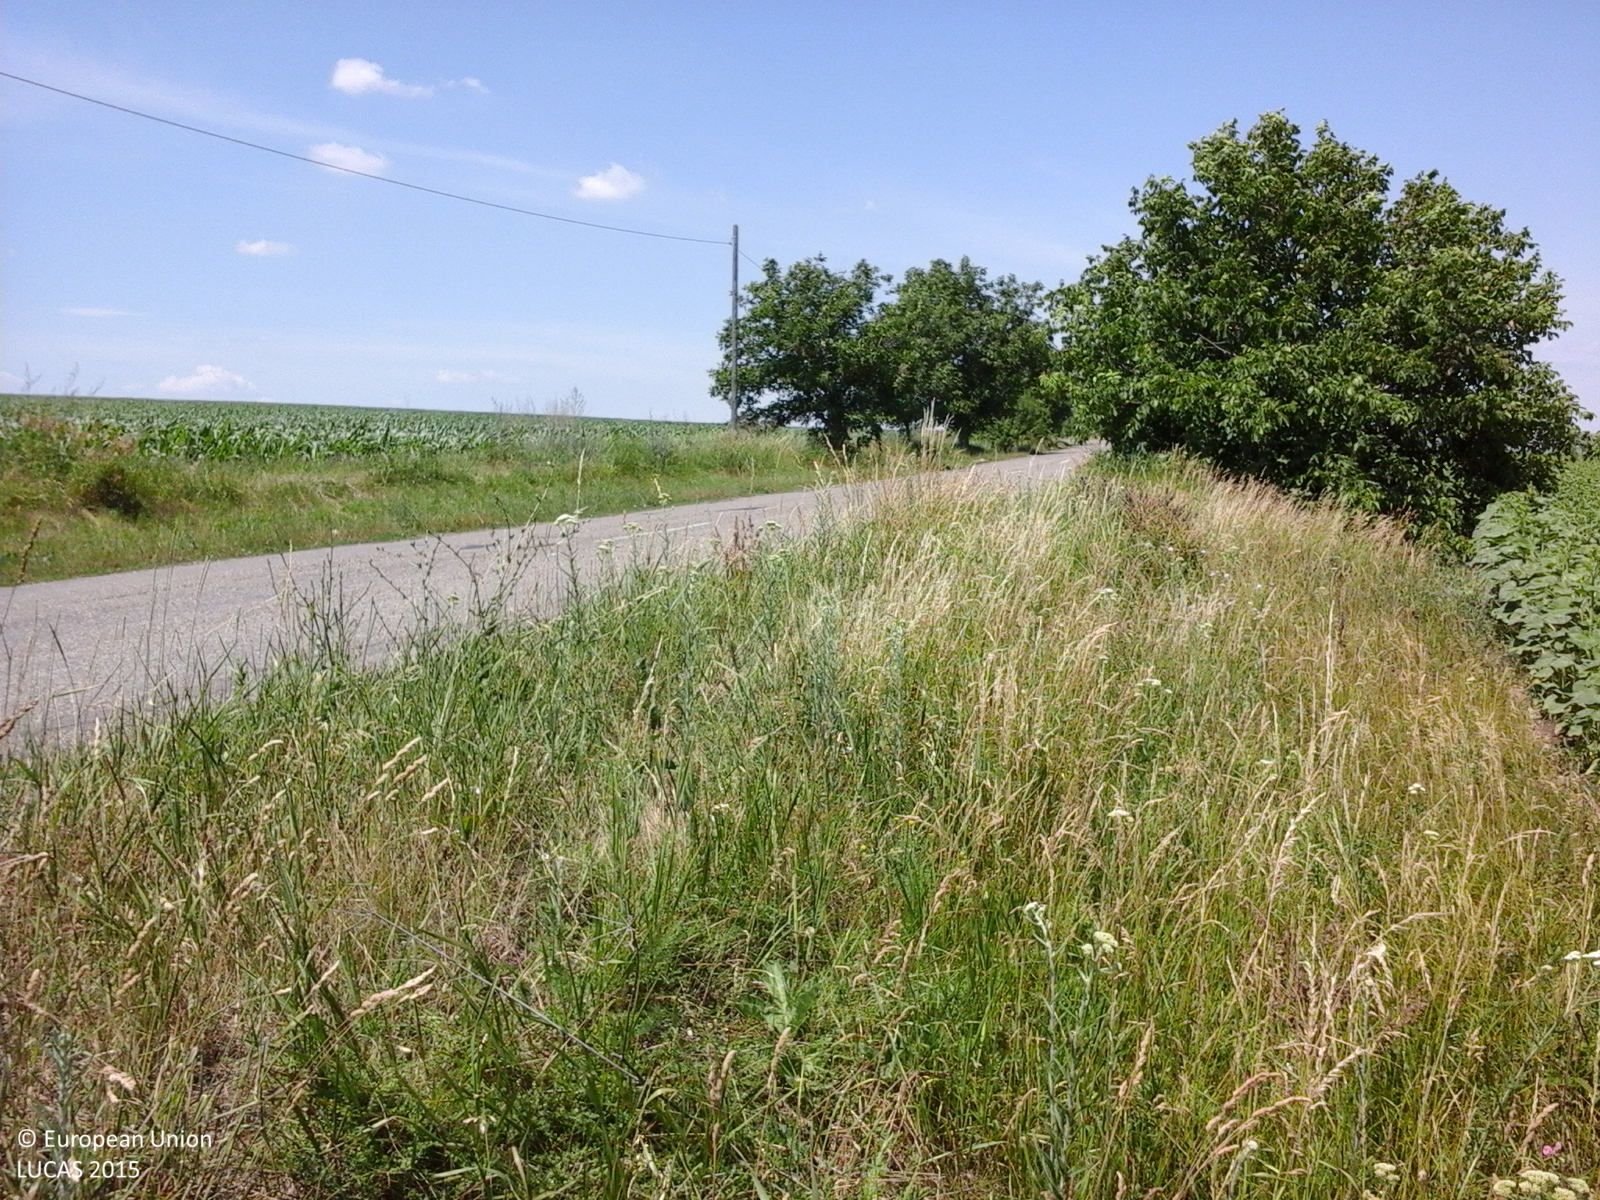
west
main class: Cropland
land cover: Sunflower
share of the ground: > 75 %
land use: Agriculture (excluding fallow land and kitchen gardens)
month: June
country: RO
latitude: 47.9761
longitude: 27.1096
